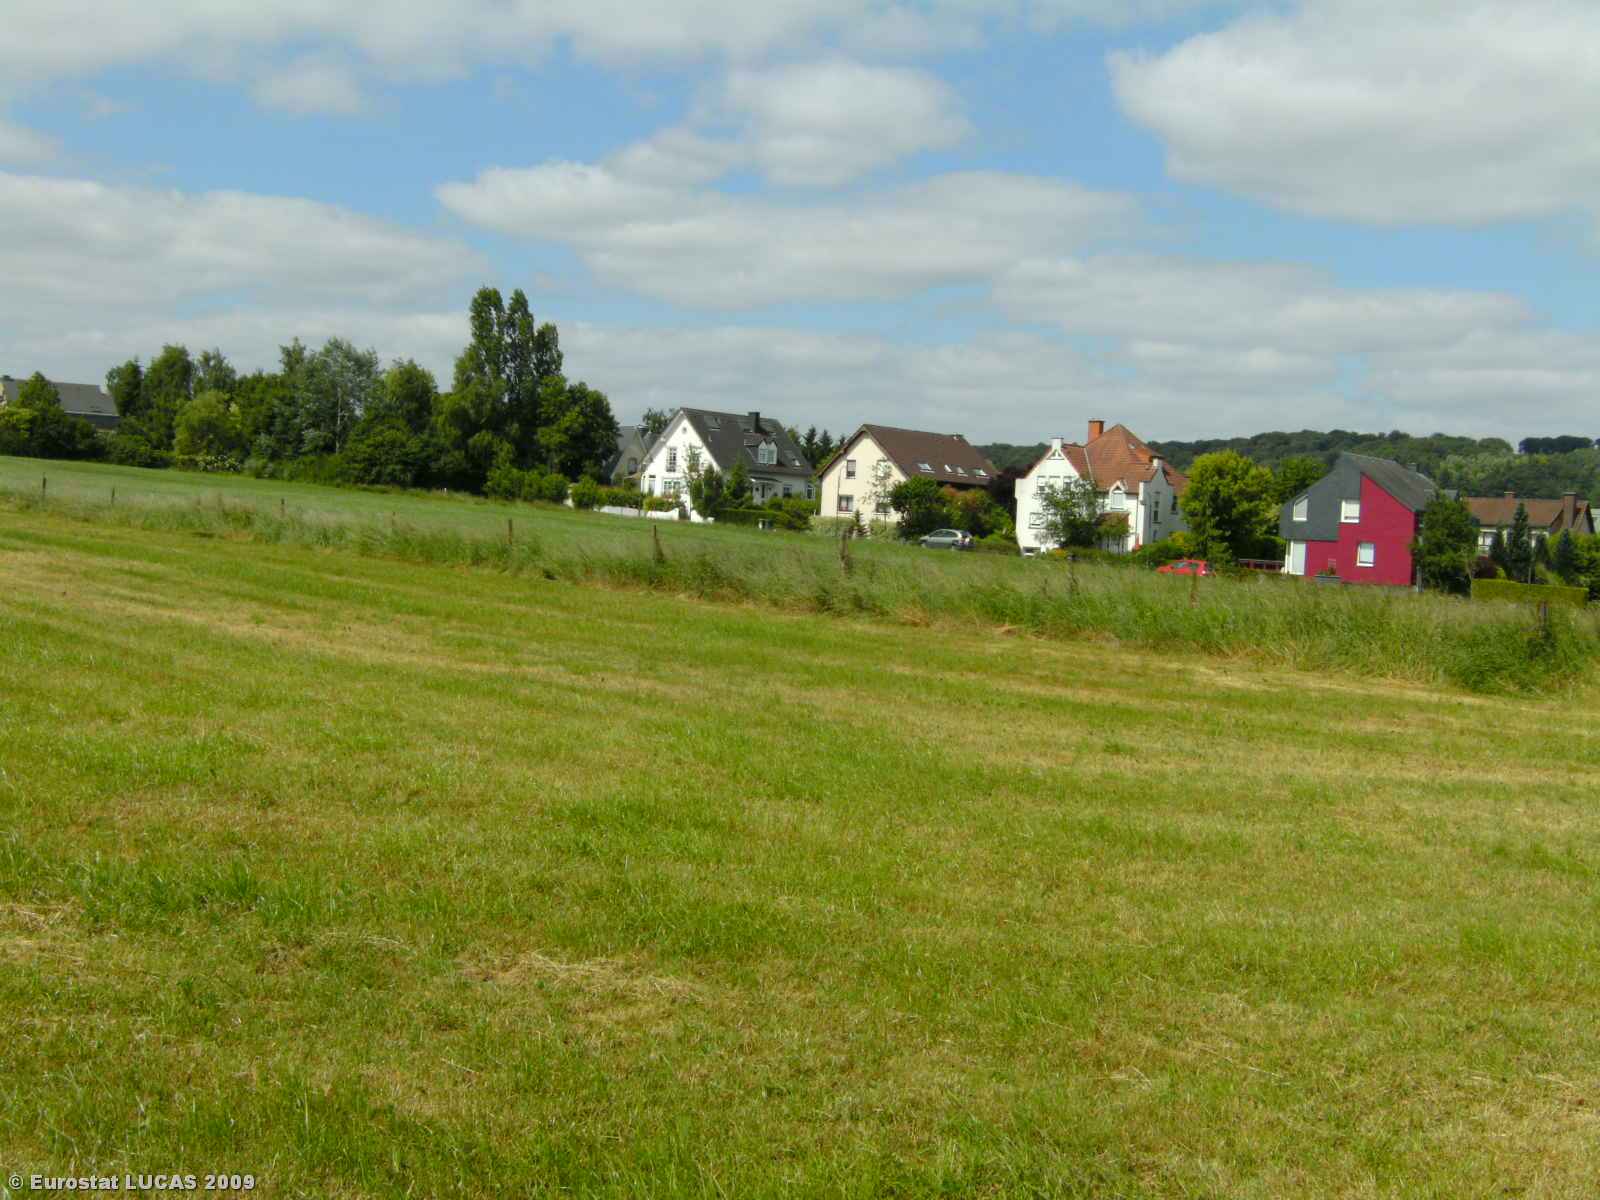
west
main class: Grassland
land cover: Grassland without tree/shrub cover
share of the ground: > 75 %
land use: Agriculture (excluding fallow land and kitchen gardens)
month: June
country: LU
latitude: 49.6194
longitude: 6.2761
